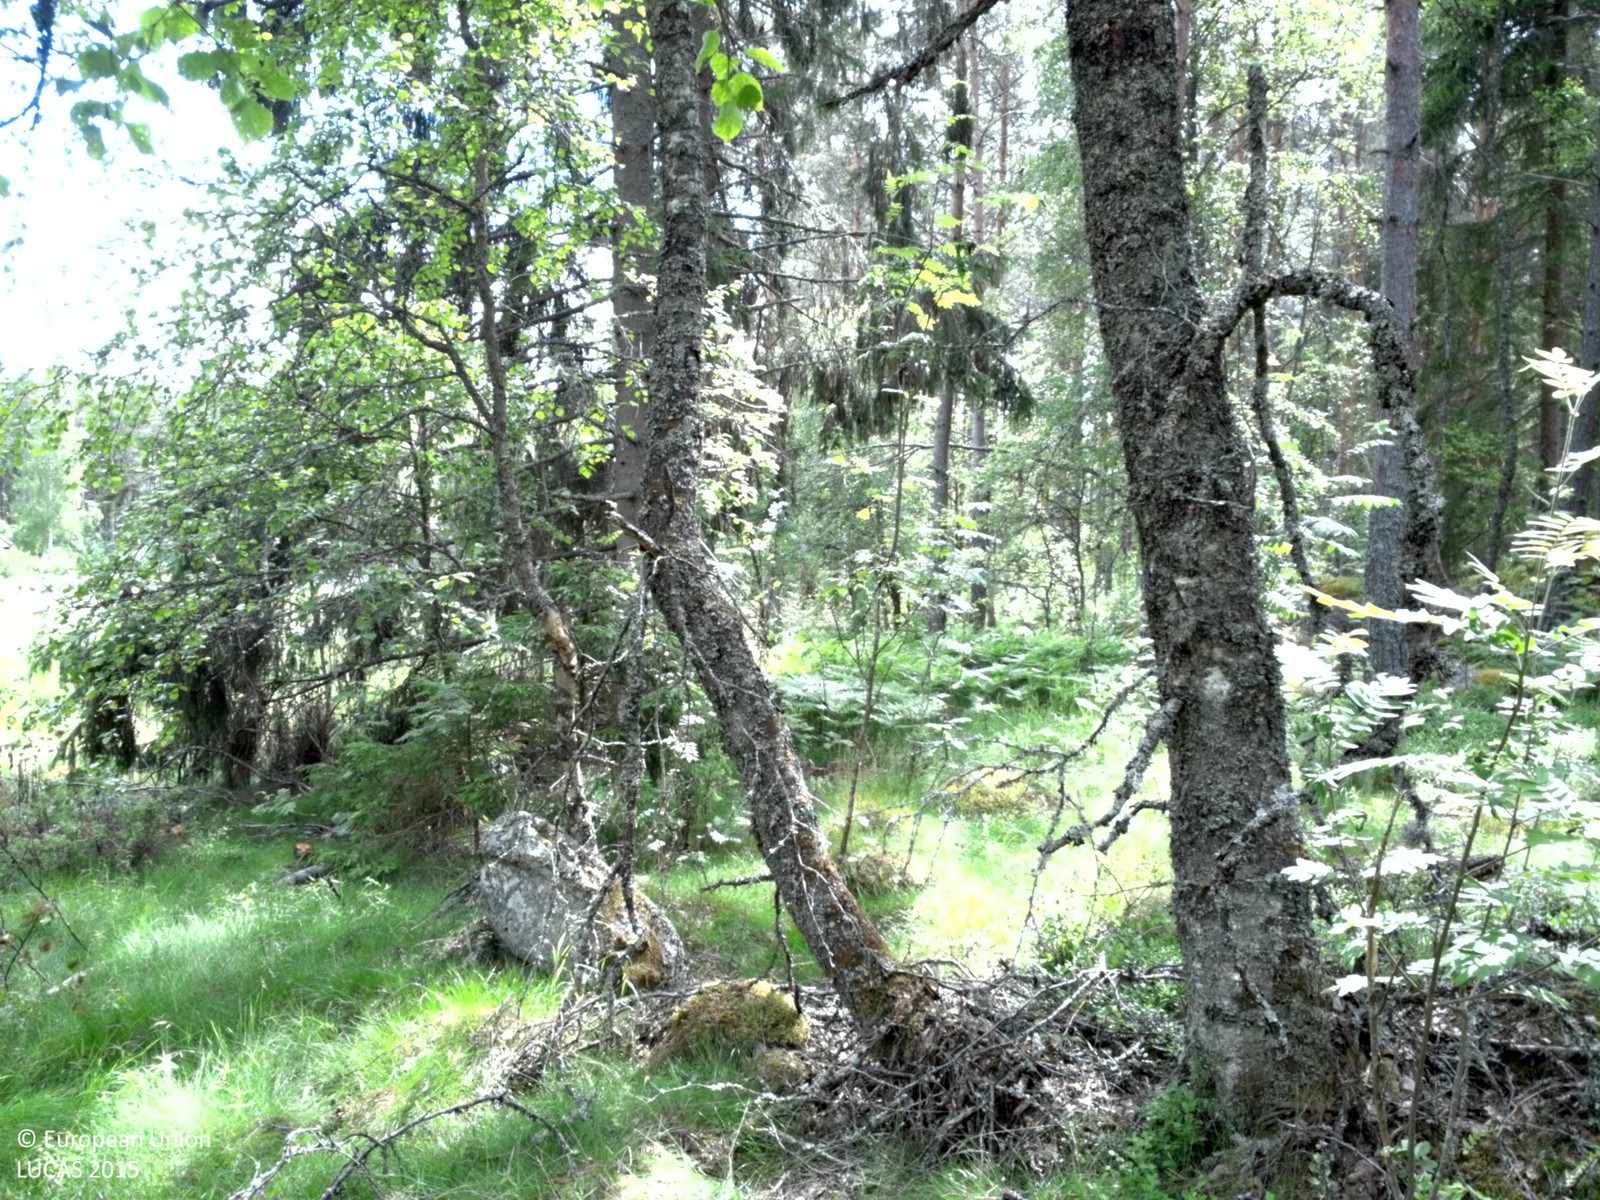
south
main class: Woodland
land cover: Broadleaved woodland
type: hemiboreal forest and nemoral coniferous forest and mixed broadleaved-coniferous forest
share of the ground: > 75 %
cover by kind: broadleaved forest trees 65 %, herbaceous plants 25 %, coniferous forest trees 10 %
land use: Forestry
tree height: > 5 m
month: June
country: SE
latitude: 59.9816
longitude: 17.1423
